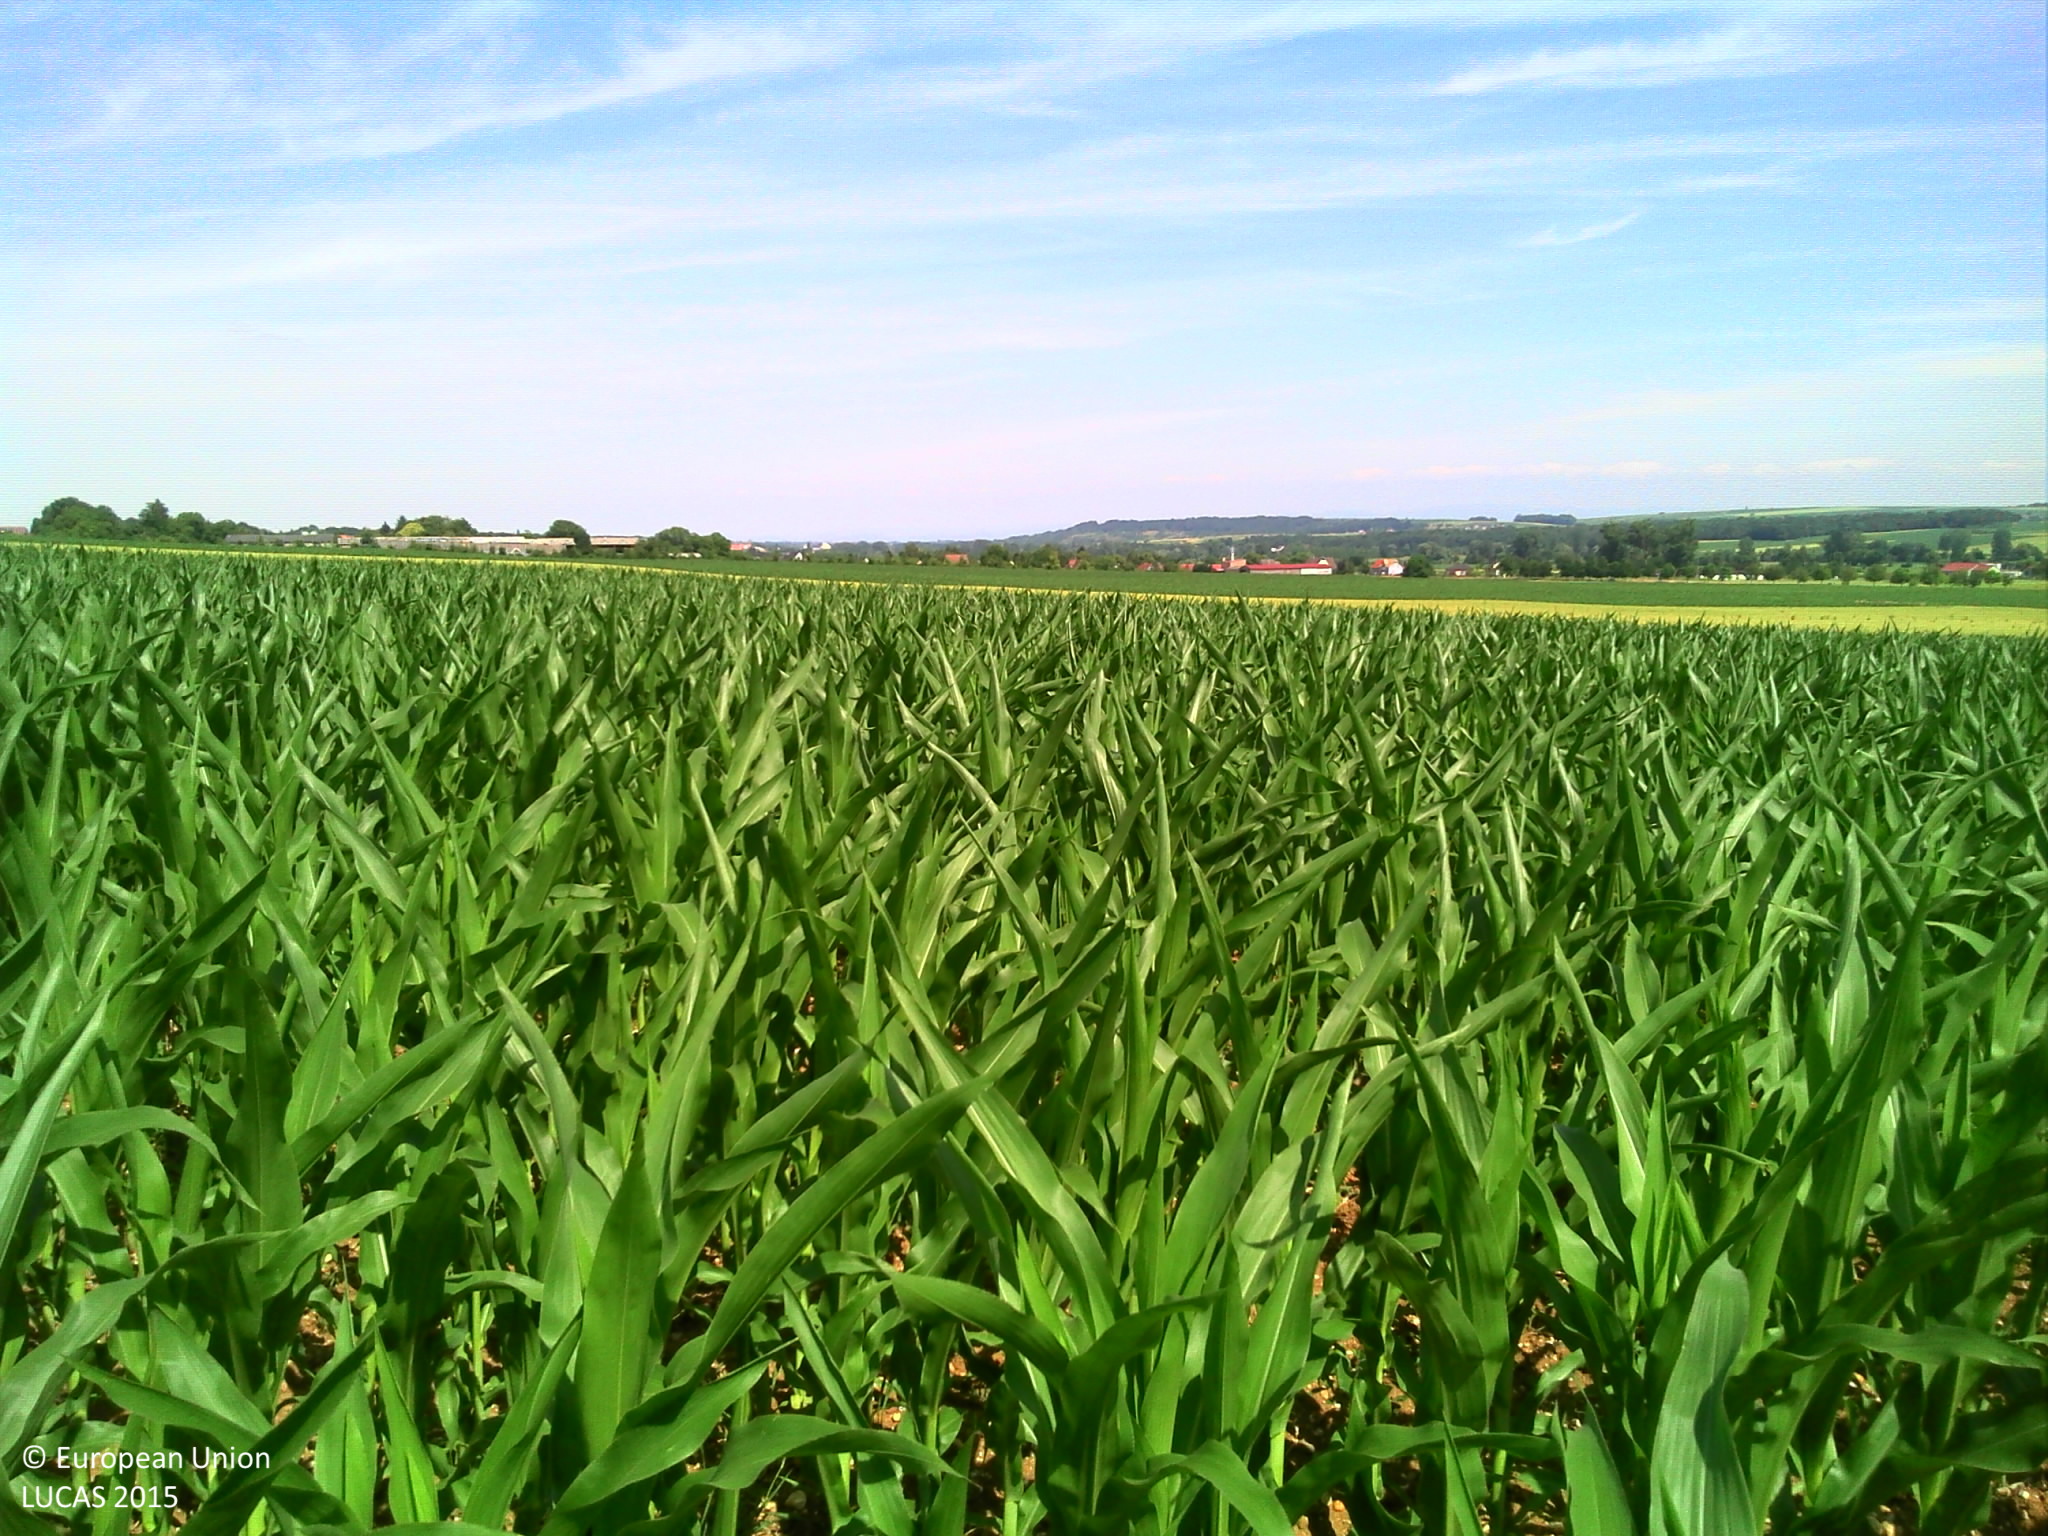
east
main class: Cropland
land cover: Maize
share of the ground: 50 - 75 %
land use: Agriculture (excluding fallow land and kitchen gardens)
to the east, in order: Maize; Grass margins; Tracks; Grass margins; Common wheat
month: June
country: FR
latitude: 48.7535
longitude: 7.5116
